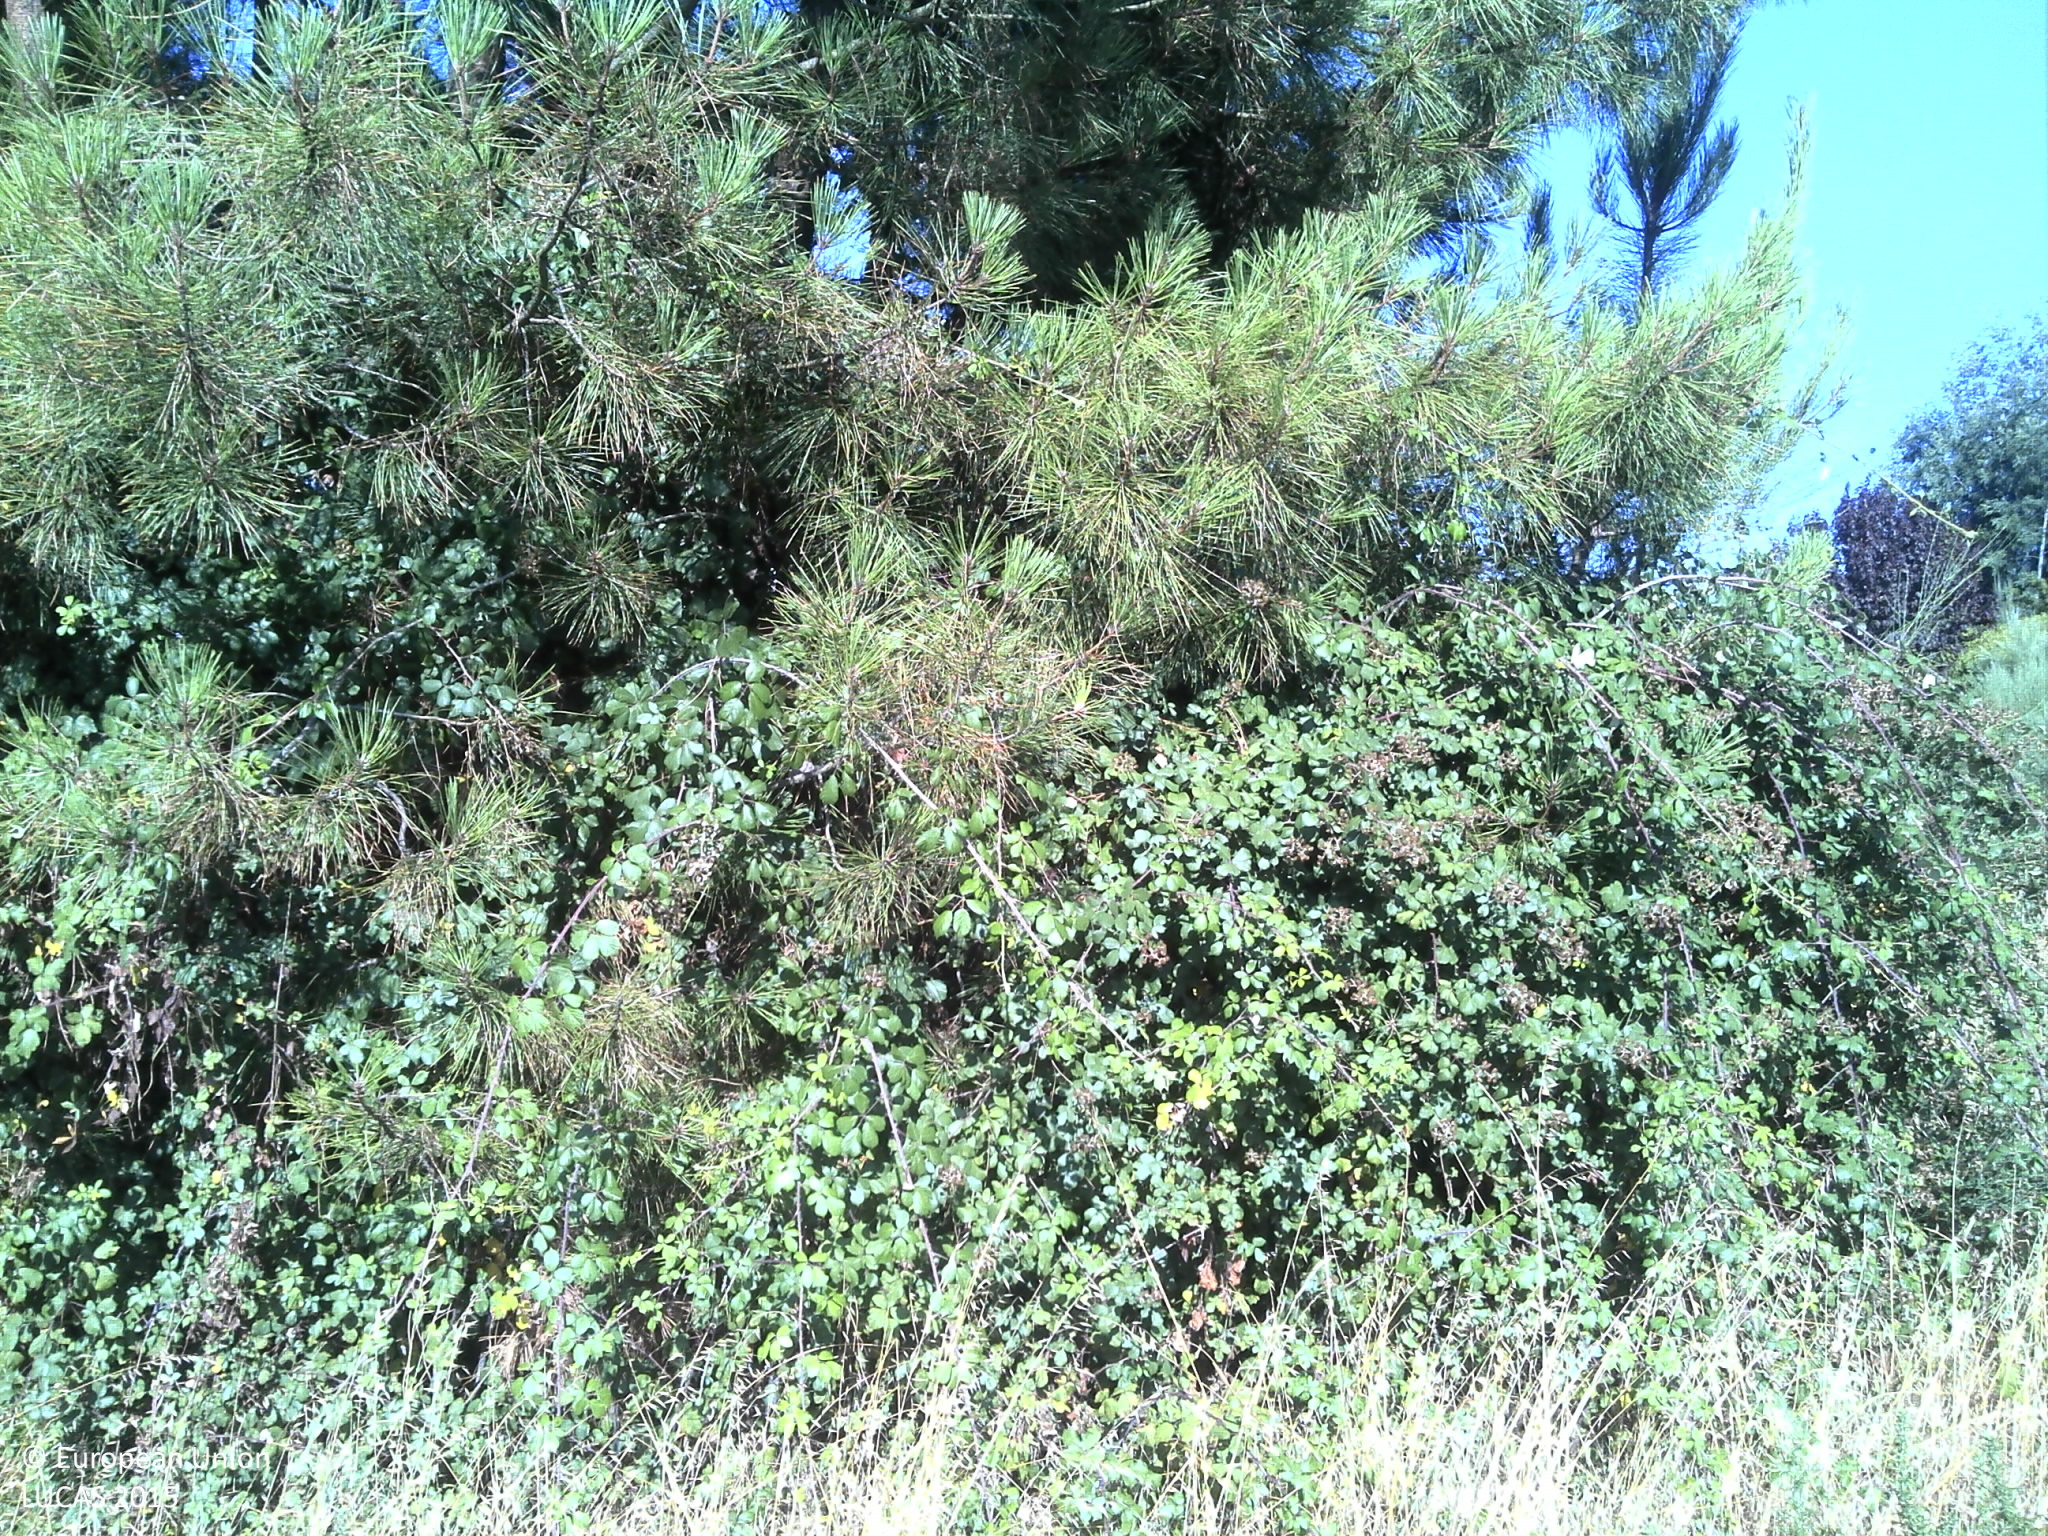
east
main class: Shrubland
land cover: Shrubland with sparse tree cover
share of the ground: > 75 %
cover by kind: shrubs 75 %, herbaceous plants 20 %, coniferous forest trees 5 %
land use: Semi-natural and natural areas not in use
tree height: > 5 m
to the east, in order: Shrubland with sparse tree cover; Abandoned hedges; Other bare soil; Shrubland without tree cover; Tracks; Grassland without tree/shrub cover; Artificial constructions; Shrubland with sparse tree cover; Artificial constructions; Paved roads, cycling and walking lanes; Grass margins; Dry stone walls; Shrubland without tree cover; Electric lines; Shrubland without tree cover
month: July
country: PT
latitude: 40.3673
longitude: -7.8654
